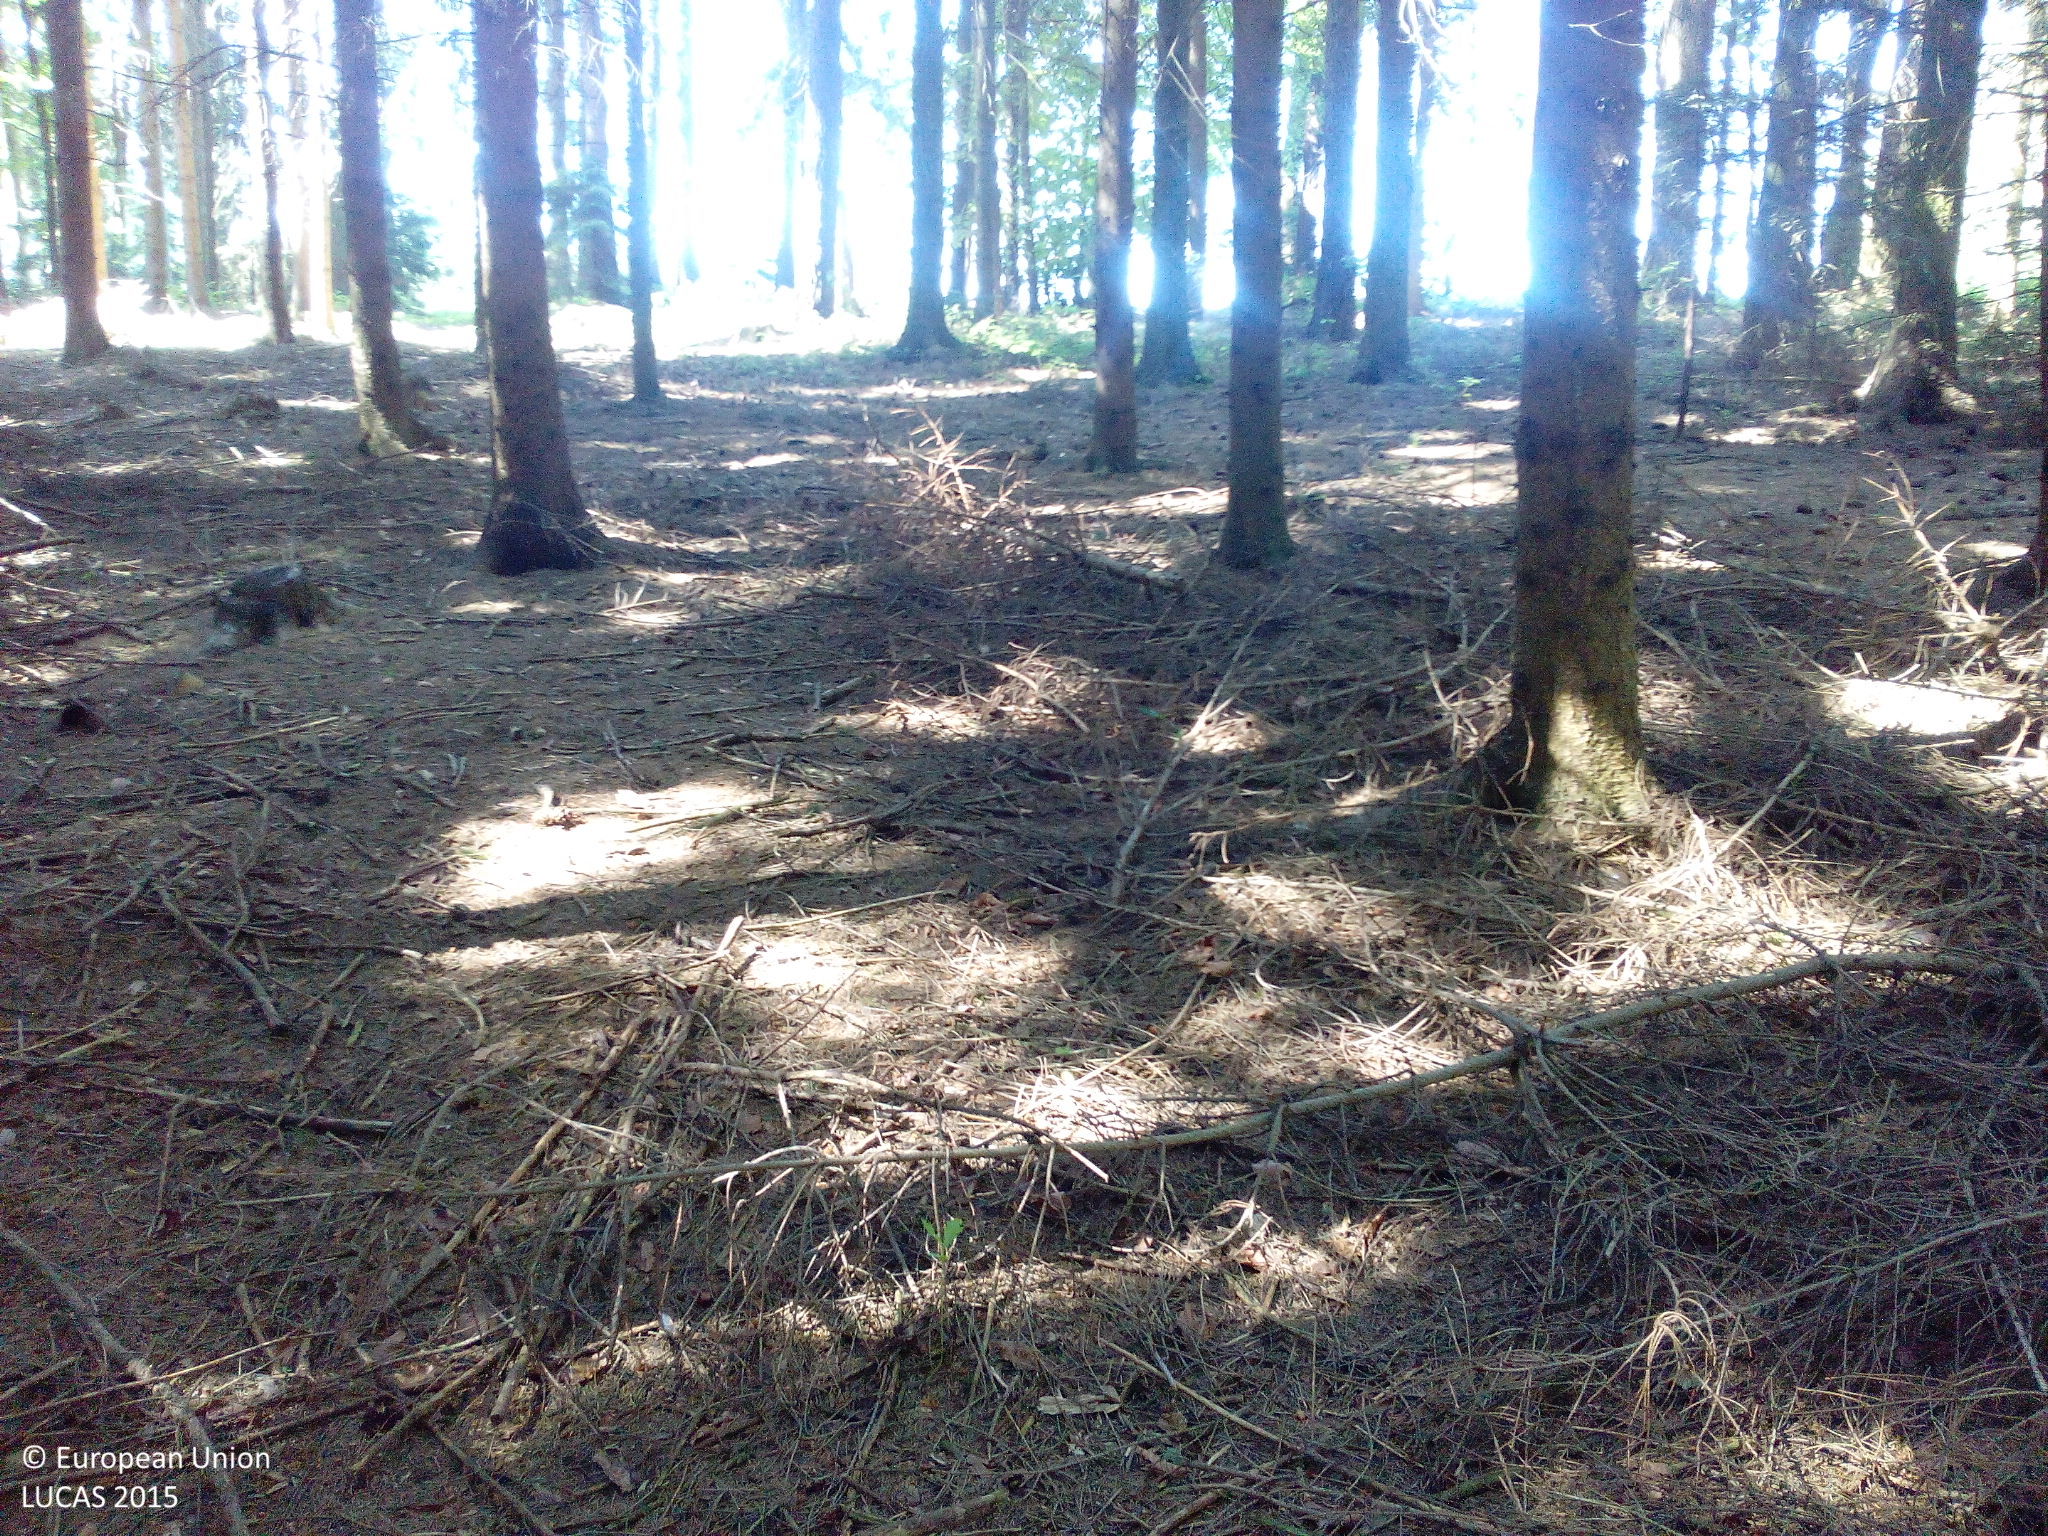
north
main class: Woodland
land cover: Spruce dominated coniferous woodland
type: hemiboreal forest and nemoral coniferous forest and mixed broadleaved-coniferous forest
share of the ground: > 75 %
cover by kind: coniferous forest trees 95 %, unconsolidated bare surface 5 %
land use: Forestry
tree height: > 5 m
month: June
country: DE
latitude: 48.6540
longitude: 12.0762
